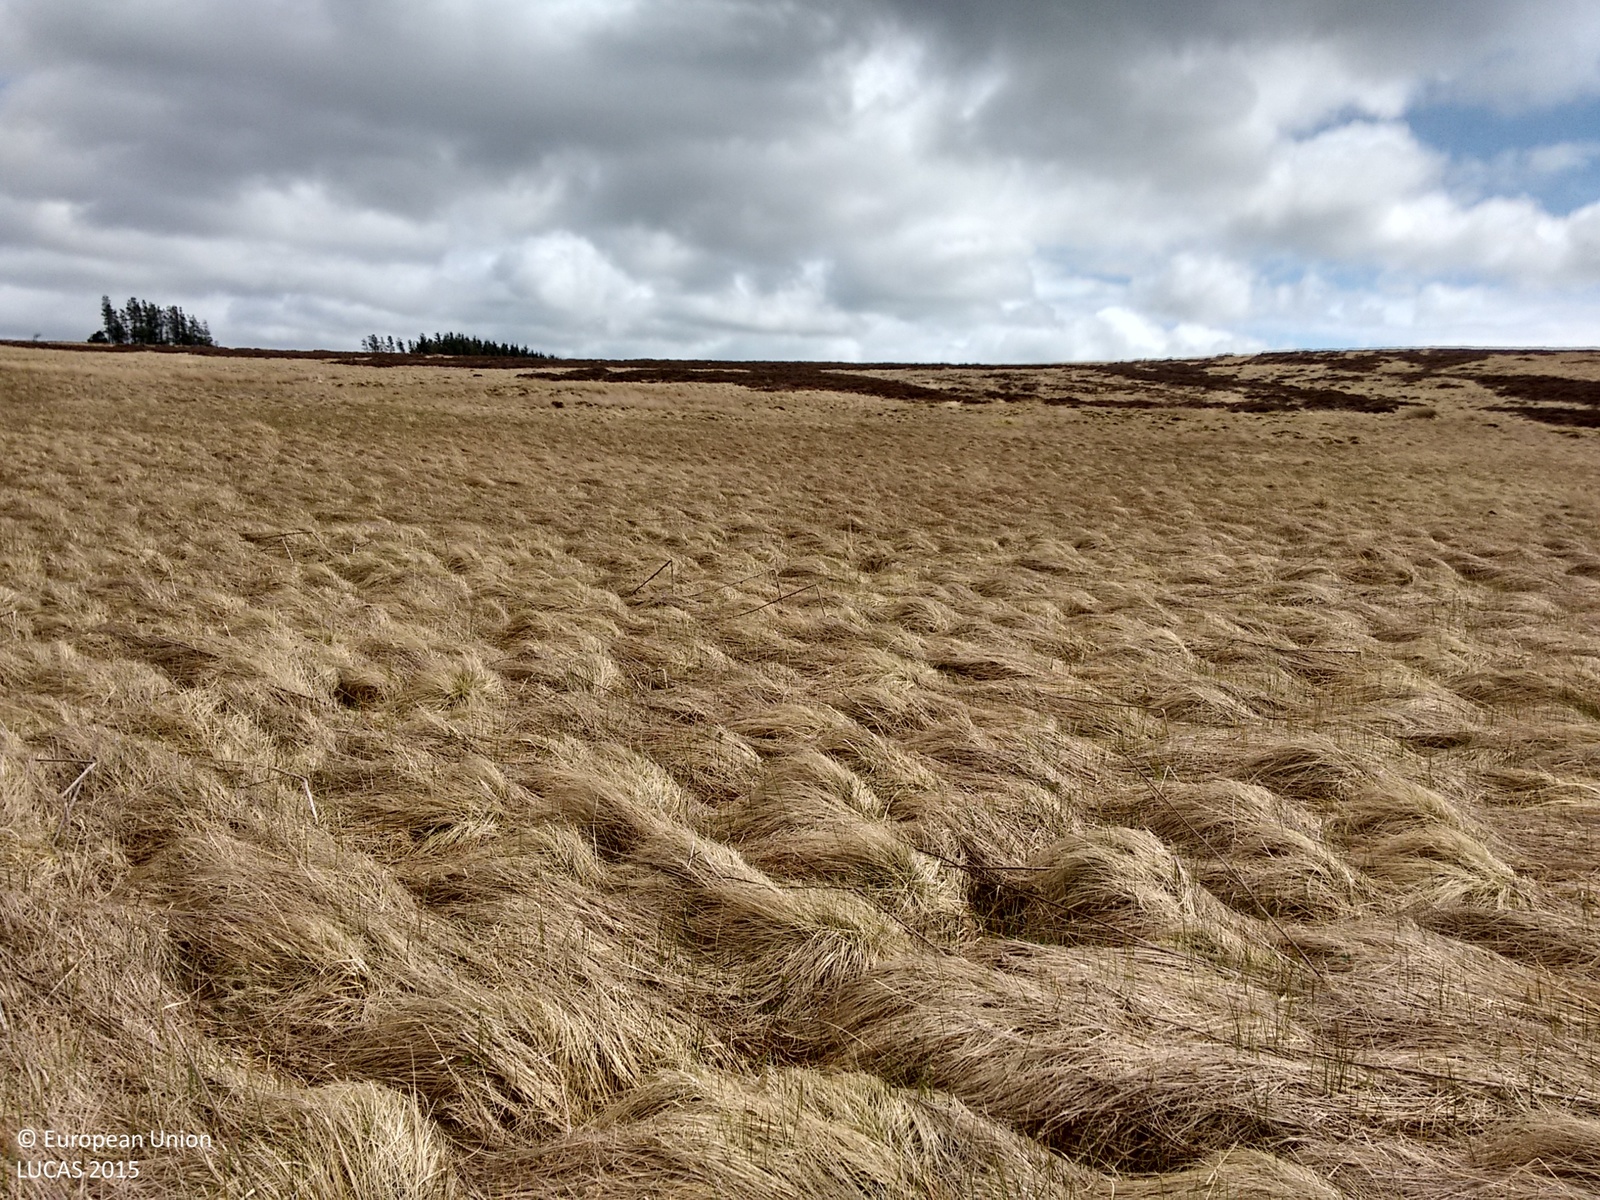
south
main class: Grassland
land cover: Grassland without tree/shrub cover
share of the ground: > 75 %
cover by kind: herbaceous plants 100 %
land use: Agriculture (excluding fallow land and kitchen gardens)
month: May
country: GB
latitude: 55.2143
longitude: -2.0786
